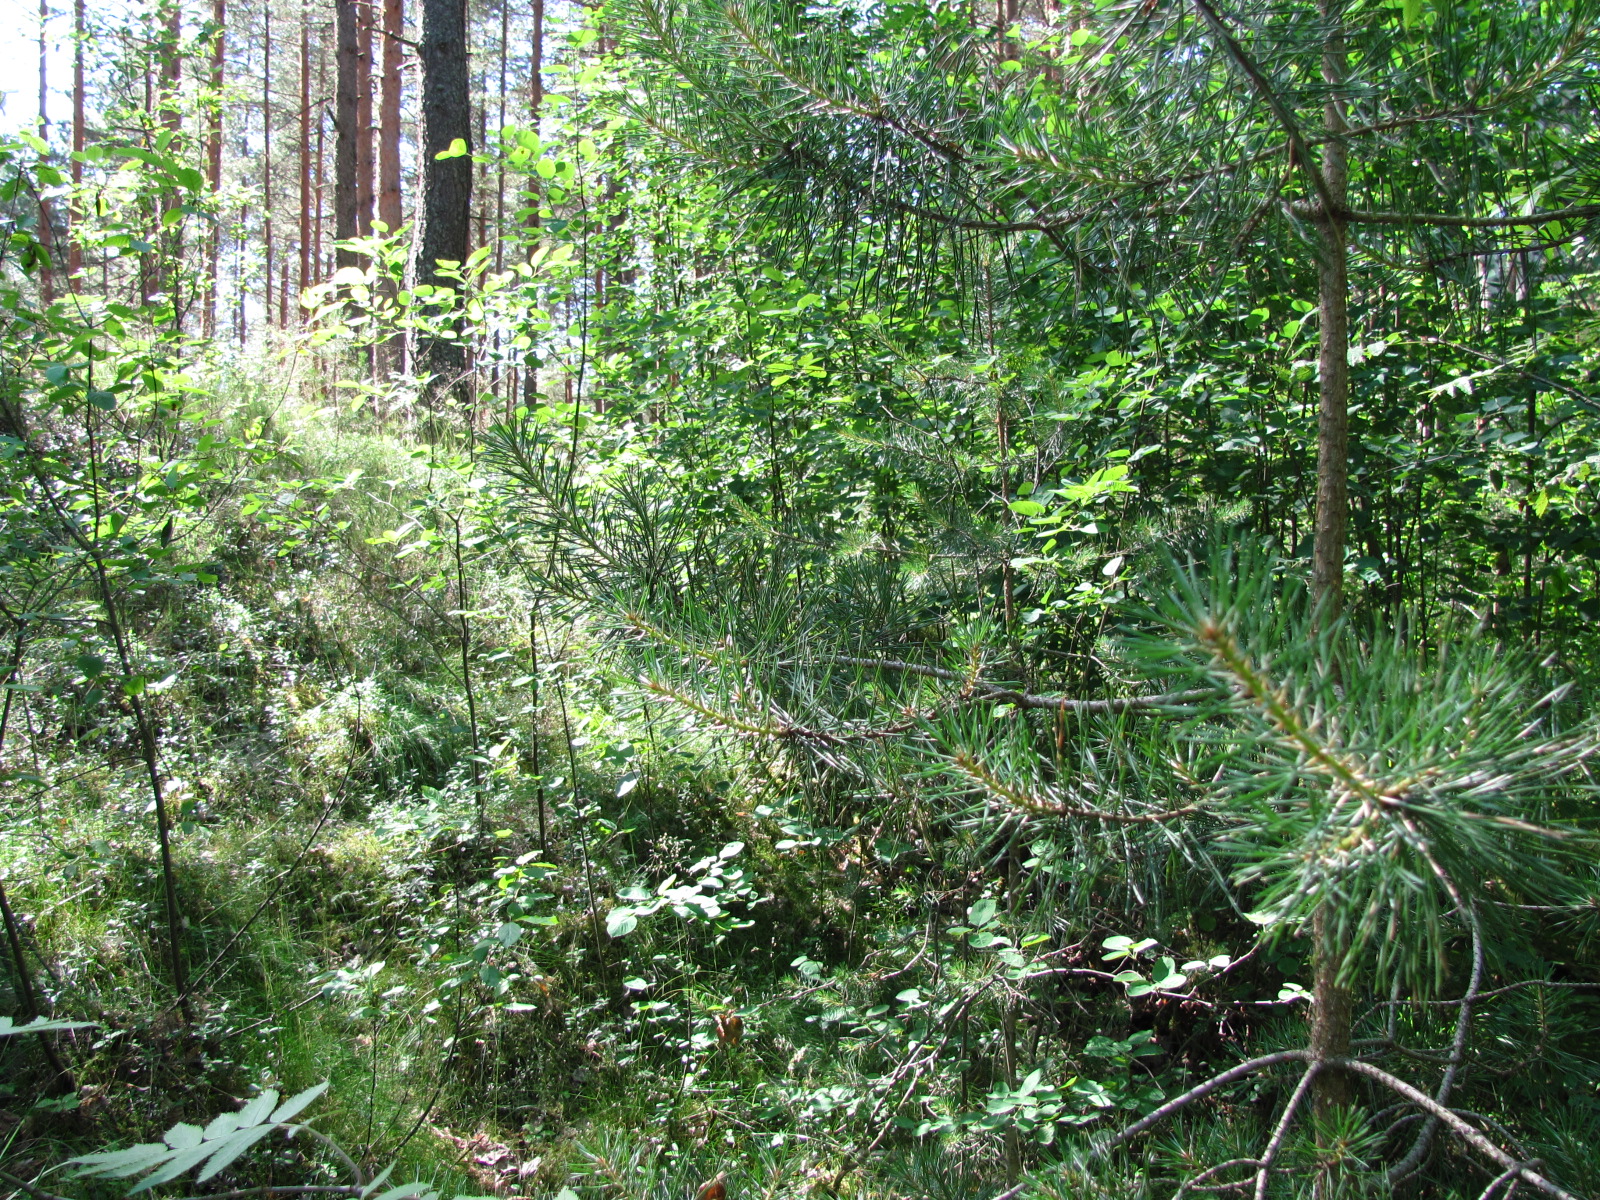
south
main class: Woodland
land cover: Pine dominated mixed woodland
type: hemiboreal forest and nemoral coniferous forest and mixed broadleaved-coniferous forest
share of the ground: > 75 %
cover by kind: coniferous forest trees 45 %, broadleaved forest trees 45 %, herbaceous plants 5 %, lichens and mosses 5 %
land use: Forestry
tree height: > 5 m
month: July
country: LV
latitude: 56.8833
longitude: 24.1176
